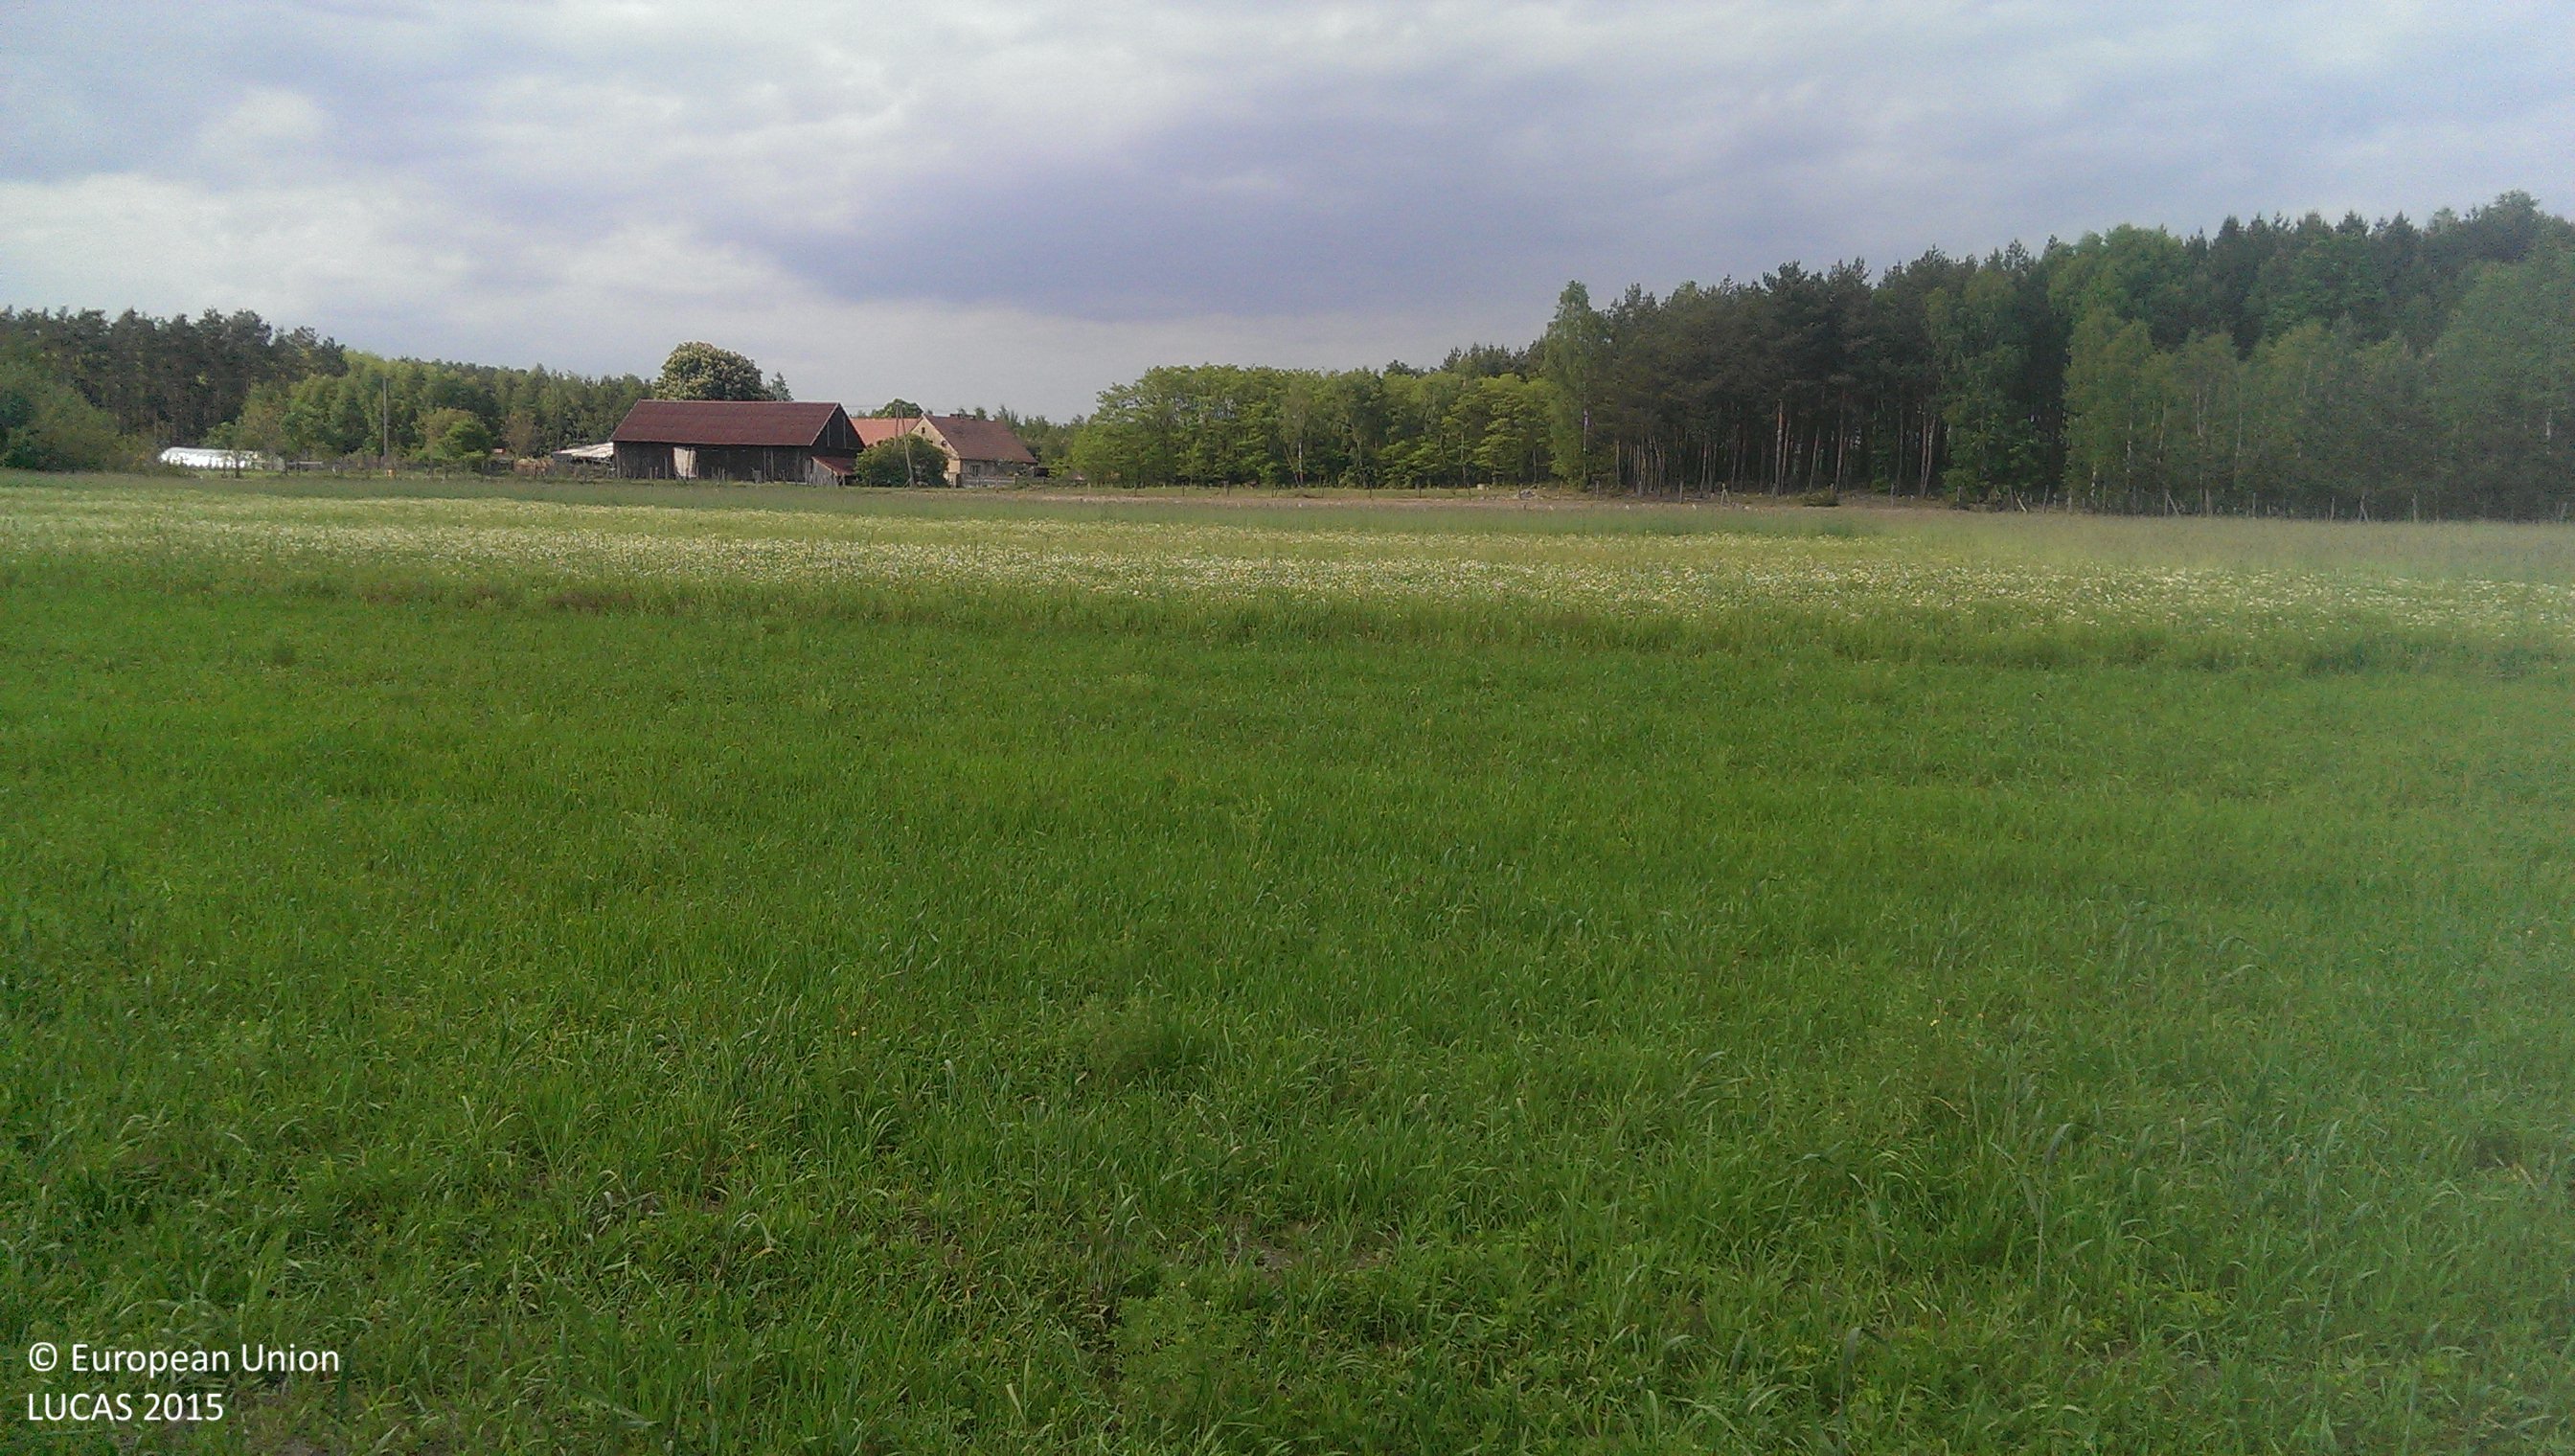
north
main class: Grassland
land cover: Grassland without tree/shrub cover
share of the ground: > 75 %
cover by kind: herbaceous plants 100 %
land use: Agriculture (excluding fallow land and kitchen gardens)
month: May
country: PL
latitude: 52.3199
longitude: 16.2711
